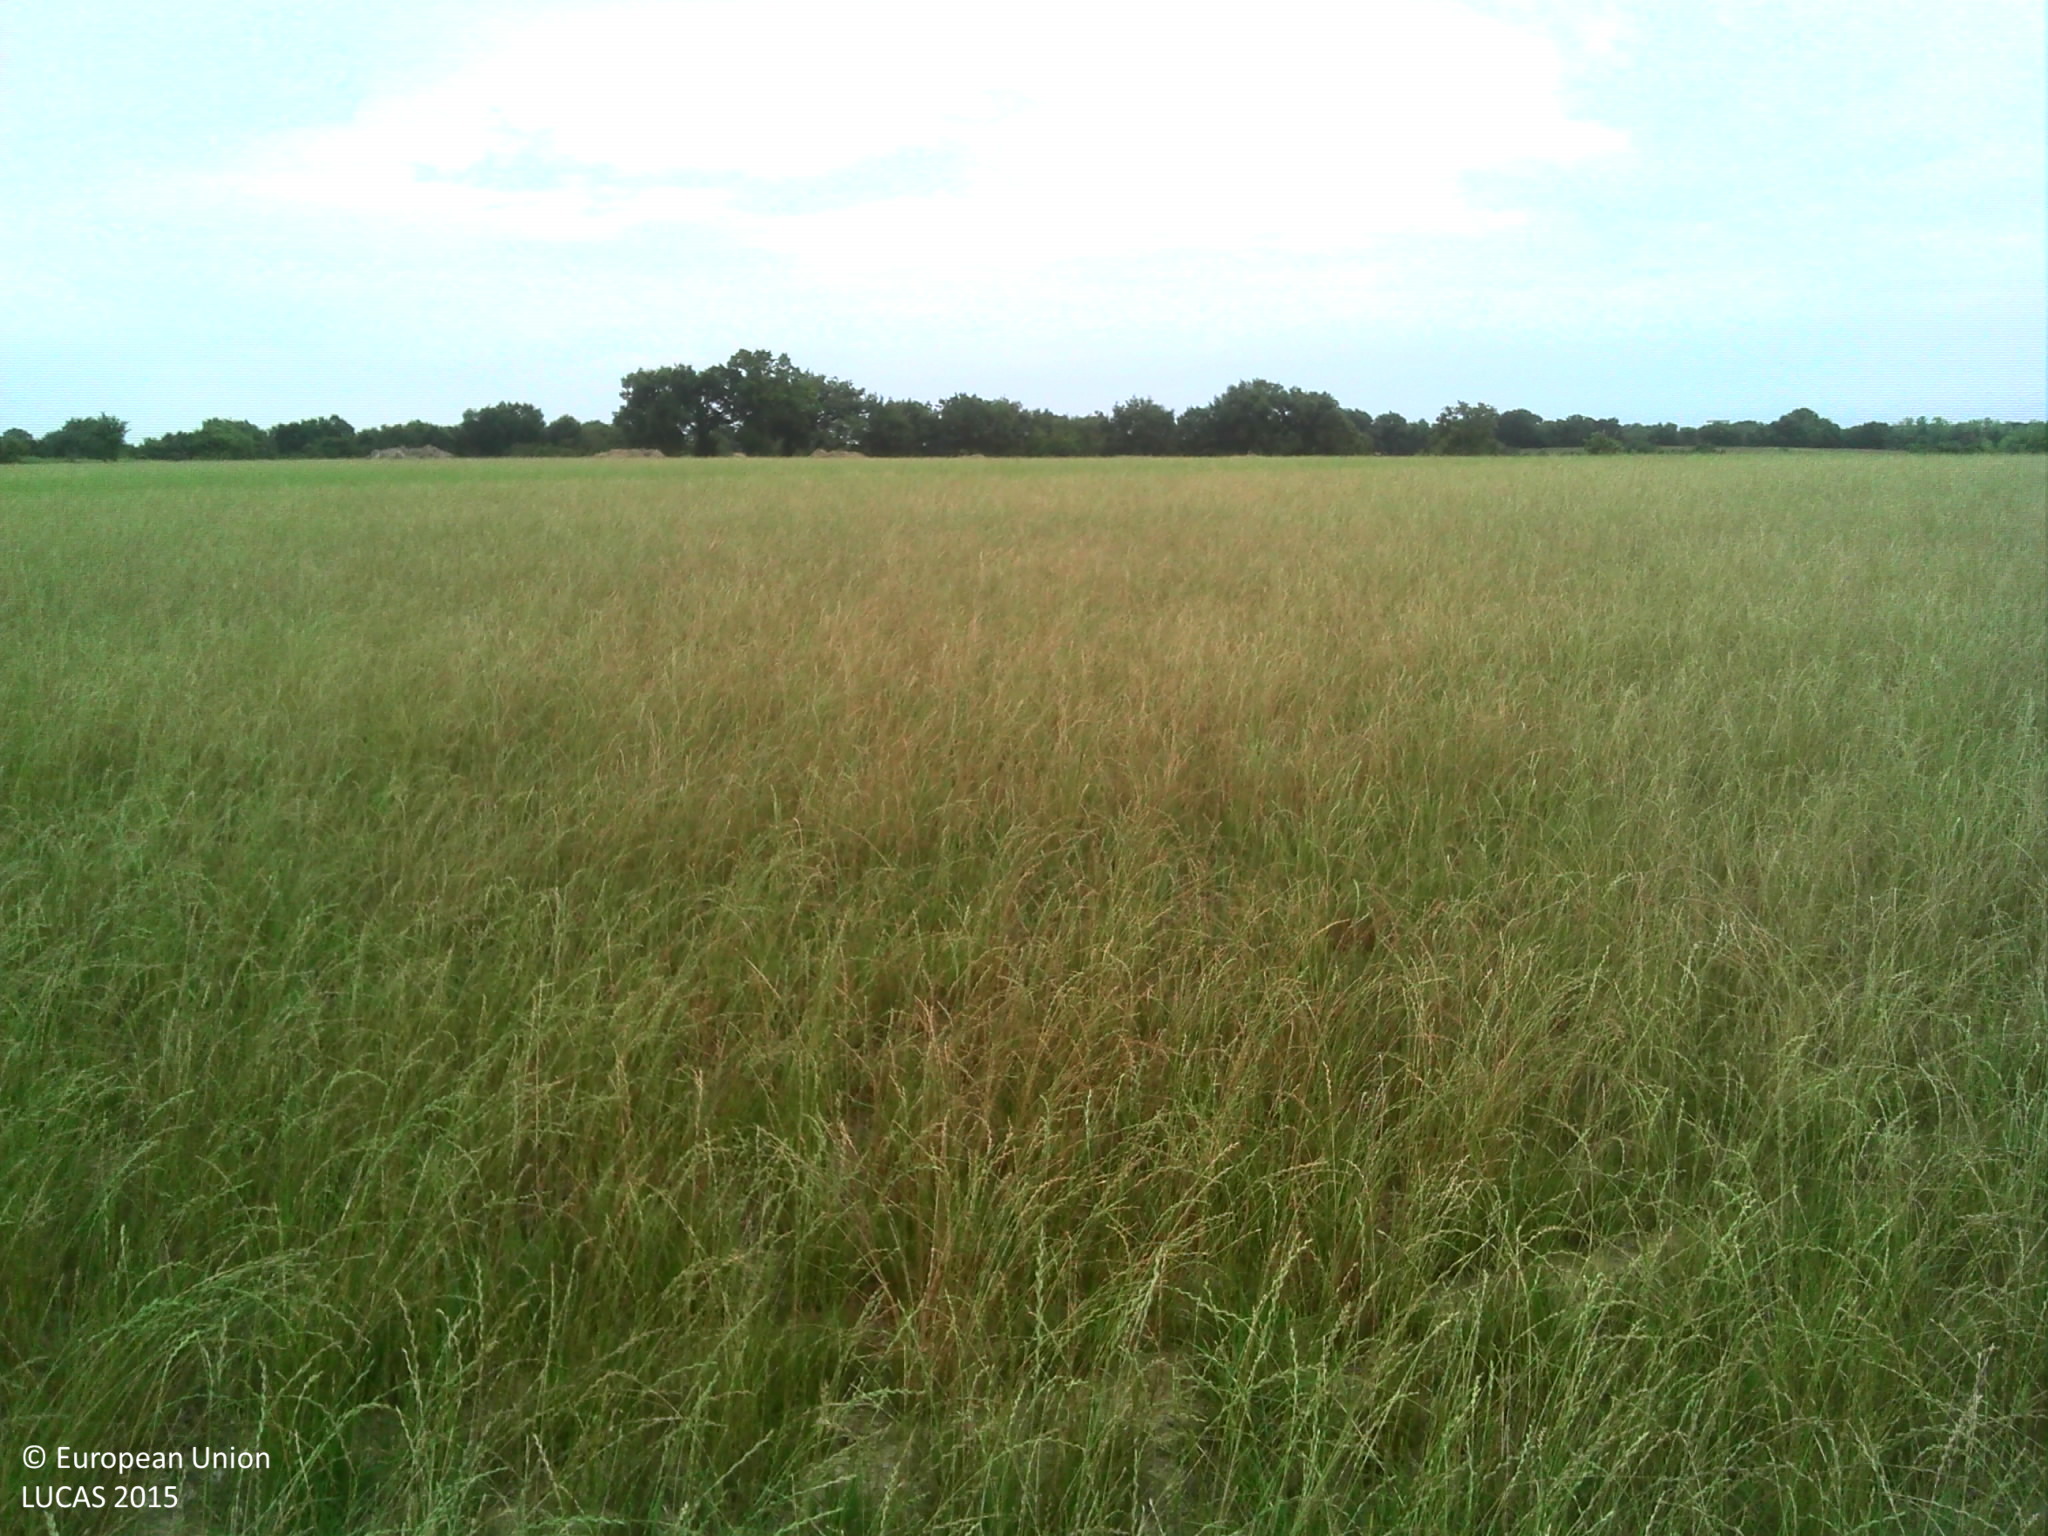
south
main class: Grassland
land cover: Grassland without tree/shrub cover
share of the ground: > 75 %
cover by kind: herbaceous plants 100 %
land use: Agriculture (excluding fallow land and kitchen gardens)
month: August
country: FR
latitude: 46.6422
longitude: -1.6282
